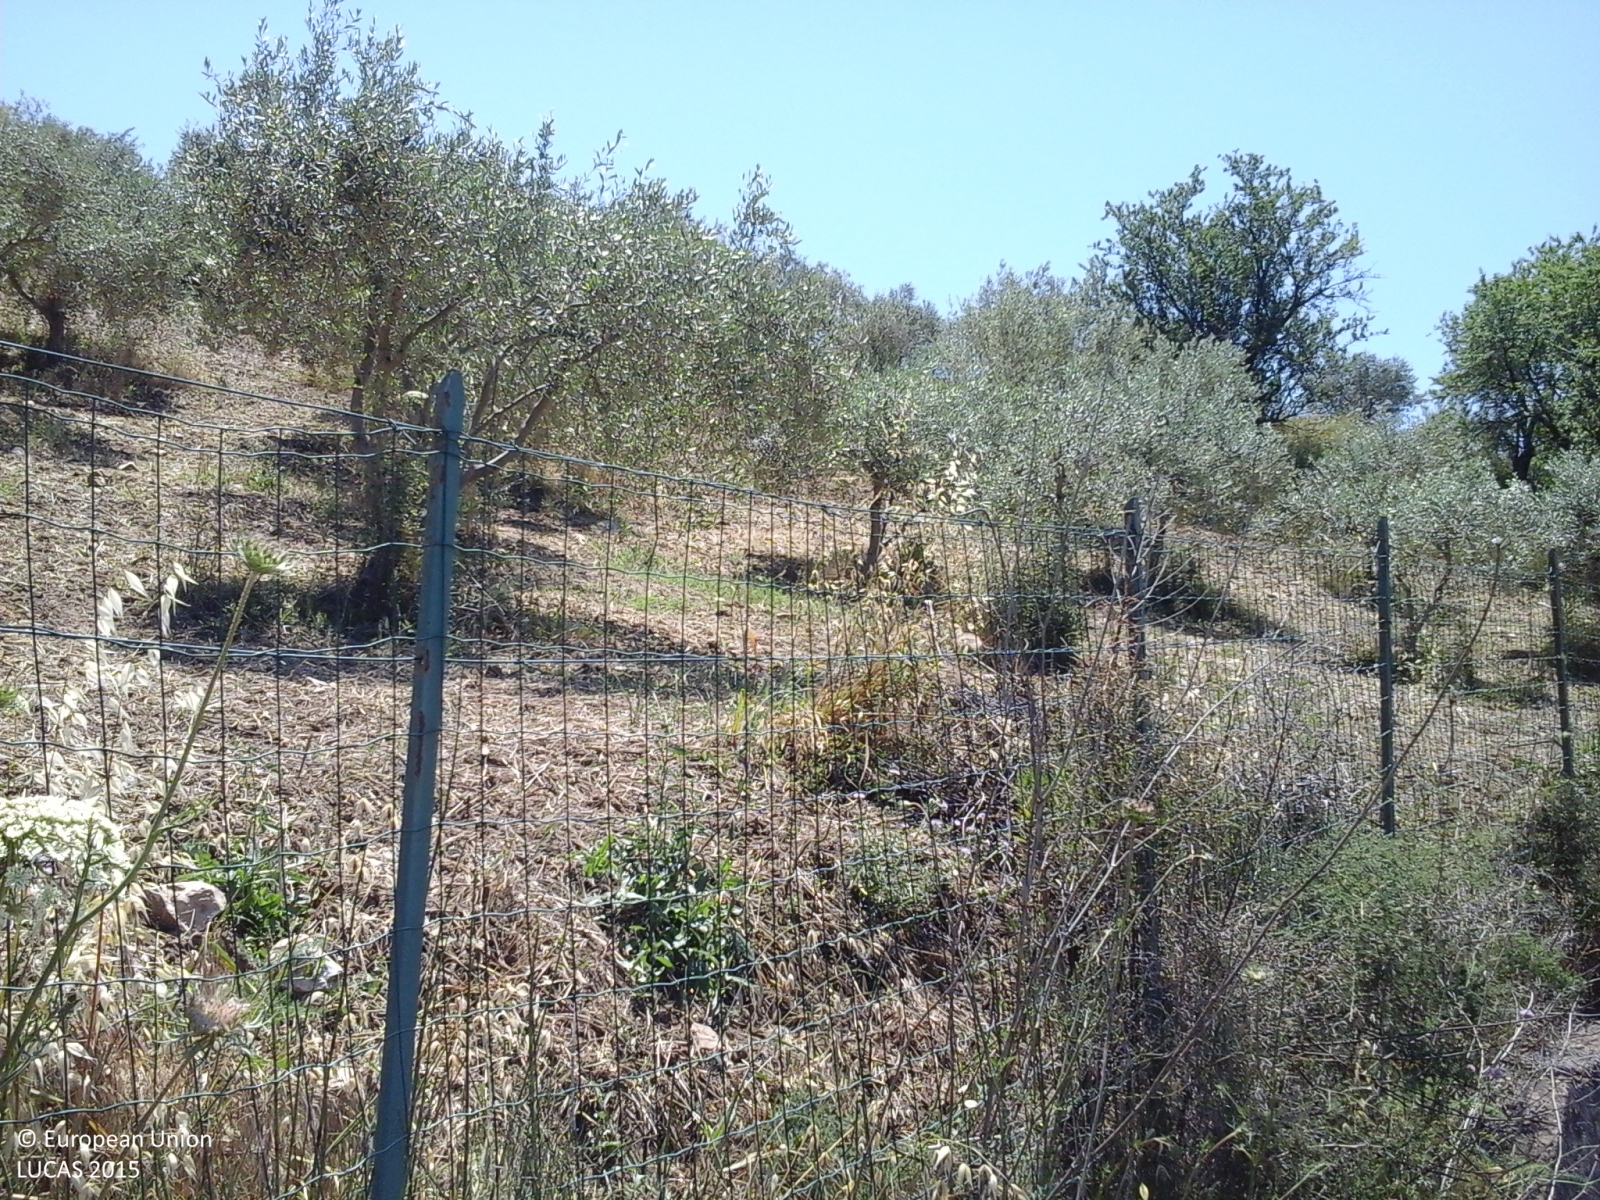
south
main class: Cropland
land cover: Olive groves
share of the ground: 50 - 75 %
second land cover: Spontaneously vegetated surfaces
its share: > 75 %
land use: Agriculture (excluding fallow land and kitchen gardens)
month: June
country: IT
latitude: 37.9500
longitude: 13.6499
